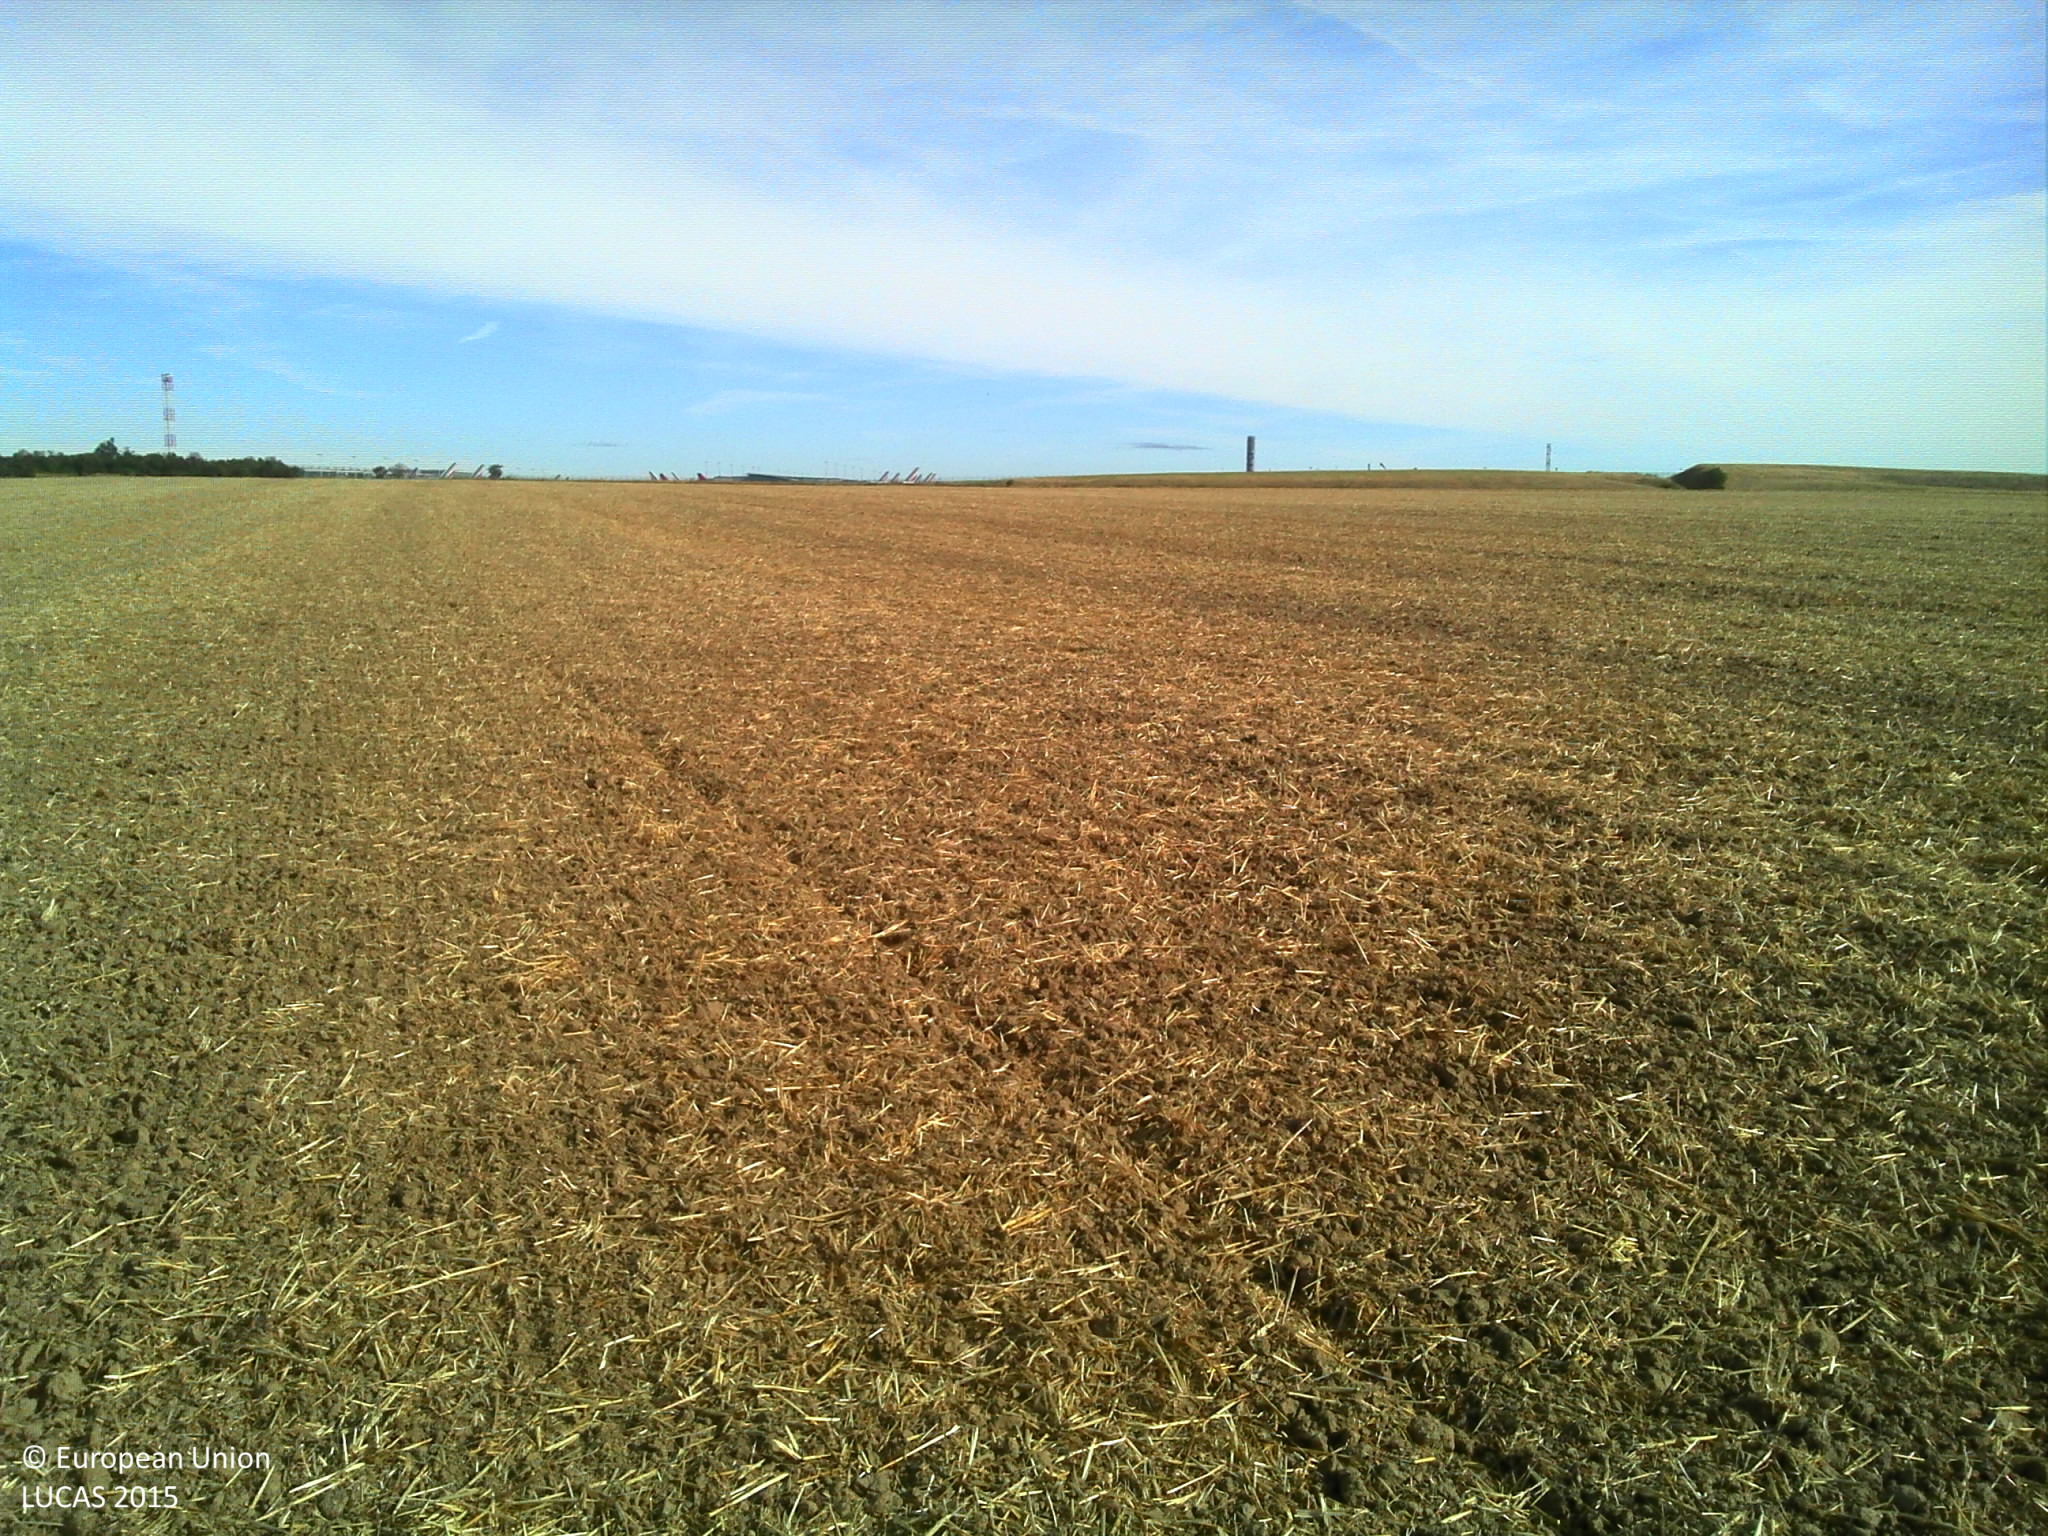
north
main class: Cropland
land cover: Common wheat
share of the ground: > 75 %
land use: Agriculture (excluding fallow land and kitchen gardens)
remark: Harvested field
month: August
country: FR
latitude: 48.9862
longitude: 2.5963
